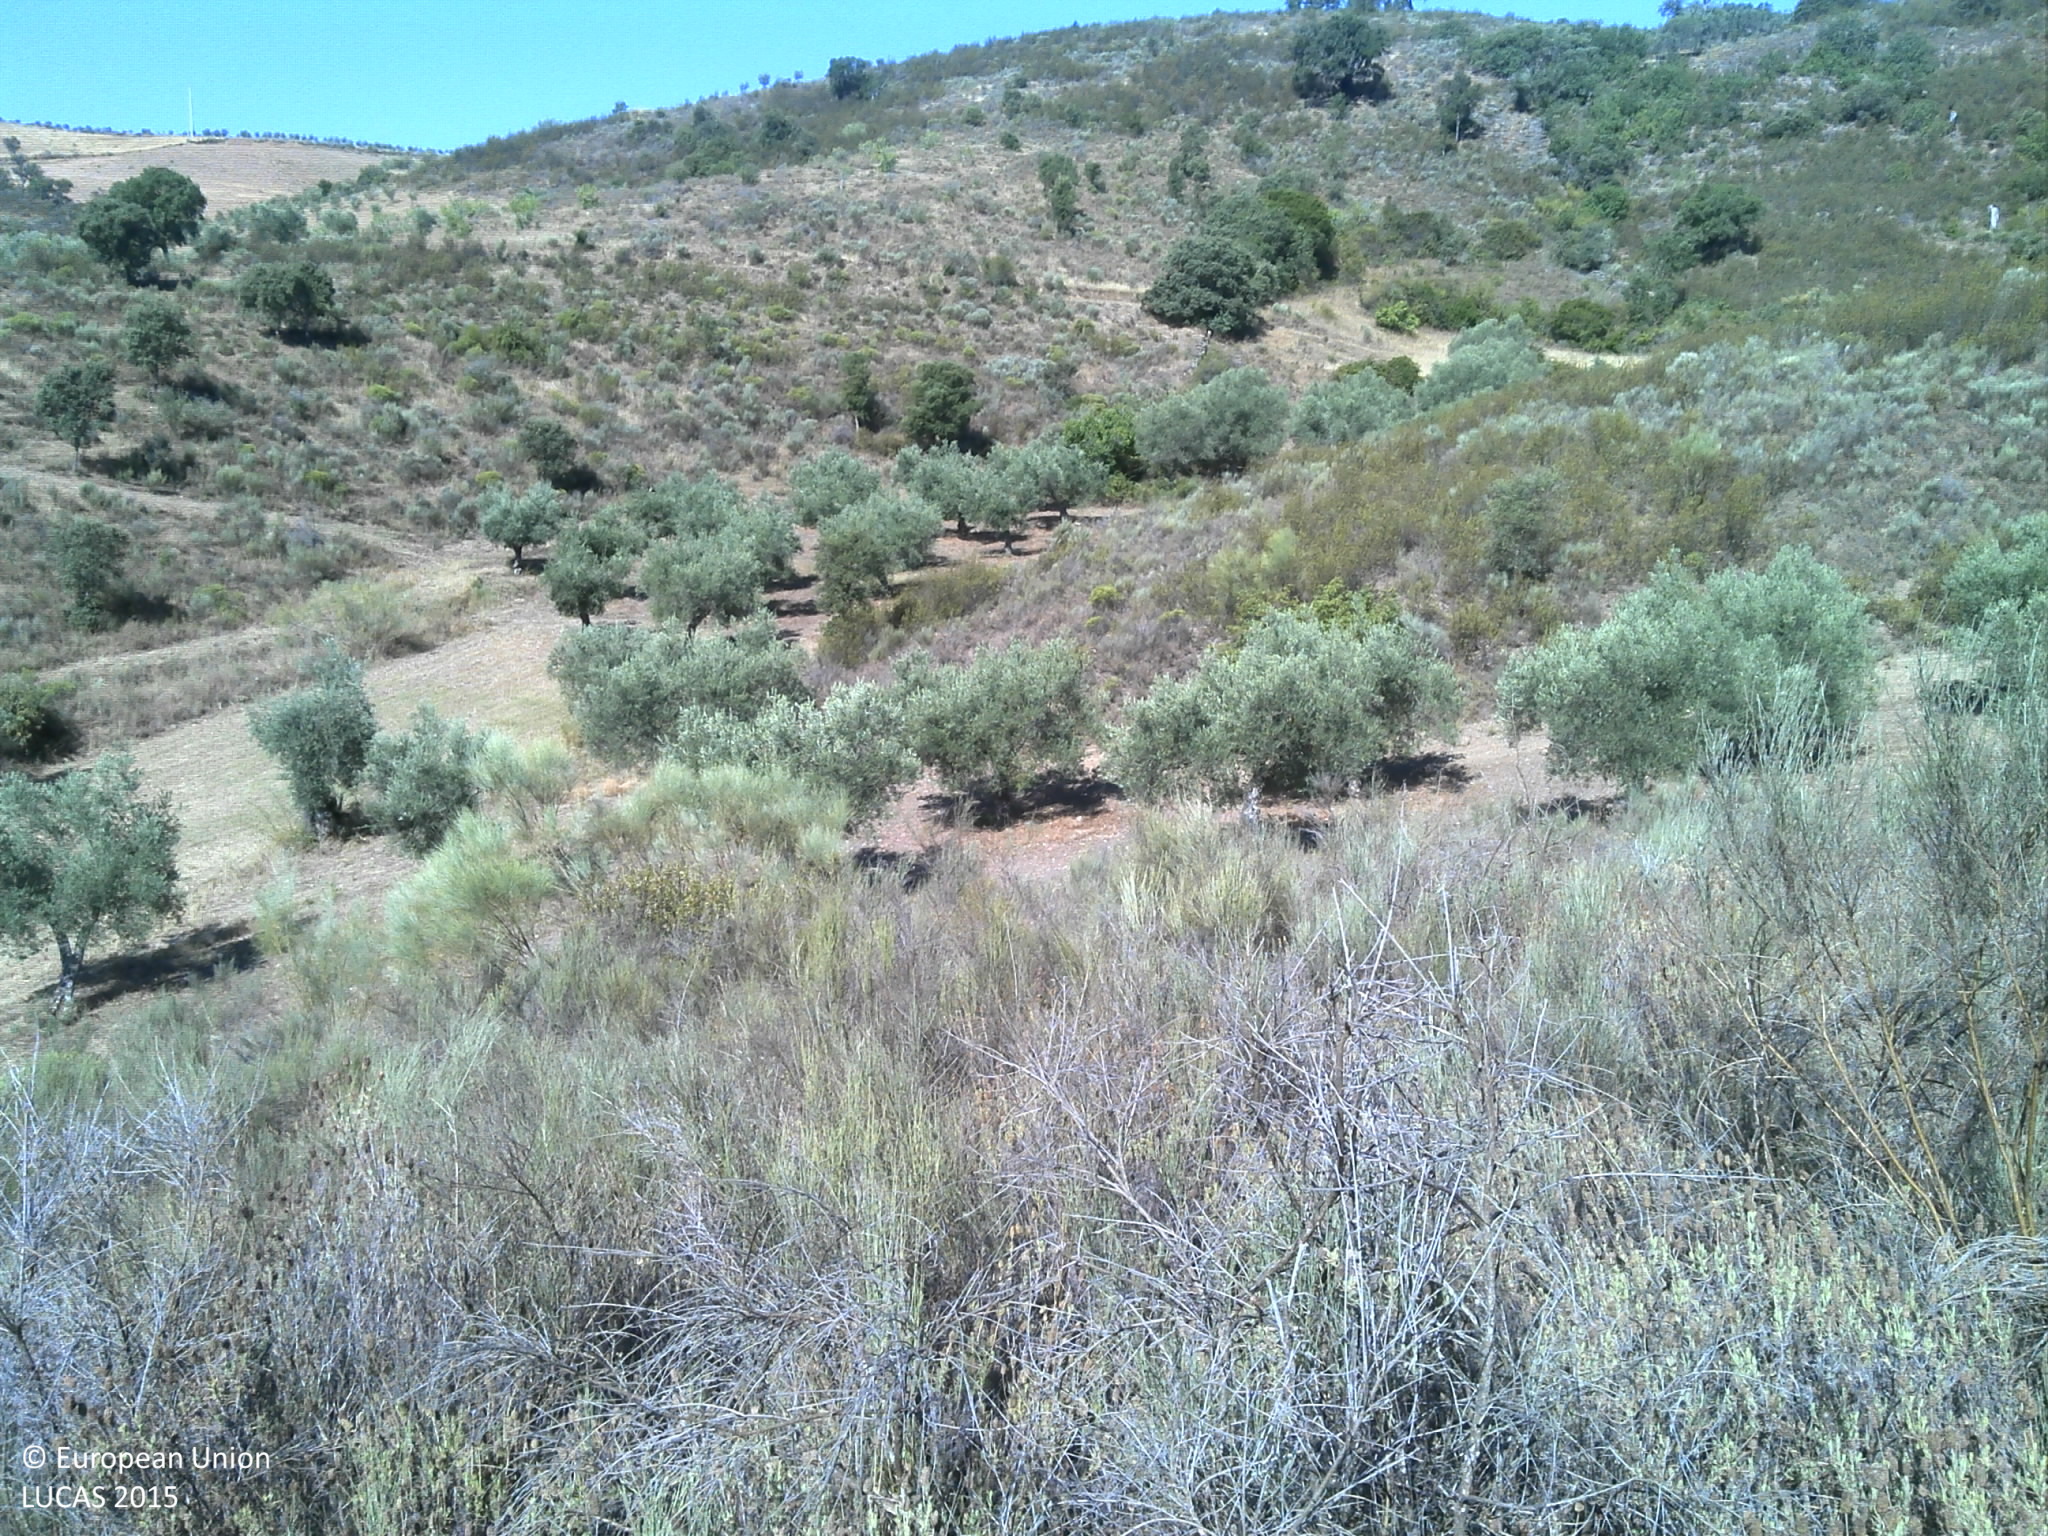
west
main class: Shrubland
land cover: Shrubland without tree cover
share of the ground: 25 - 50 %
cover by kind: shrubs 45 %, unconsolidated bare surface 35 %, herbaceous plants 10 %, consolidated bare surface 10 %
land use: Fallow land
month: July
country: PT
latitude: 41.4069
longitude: -7.2126
